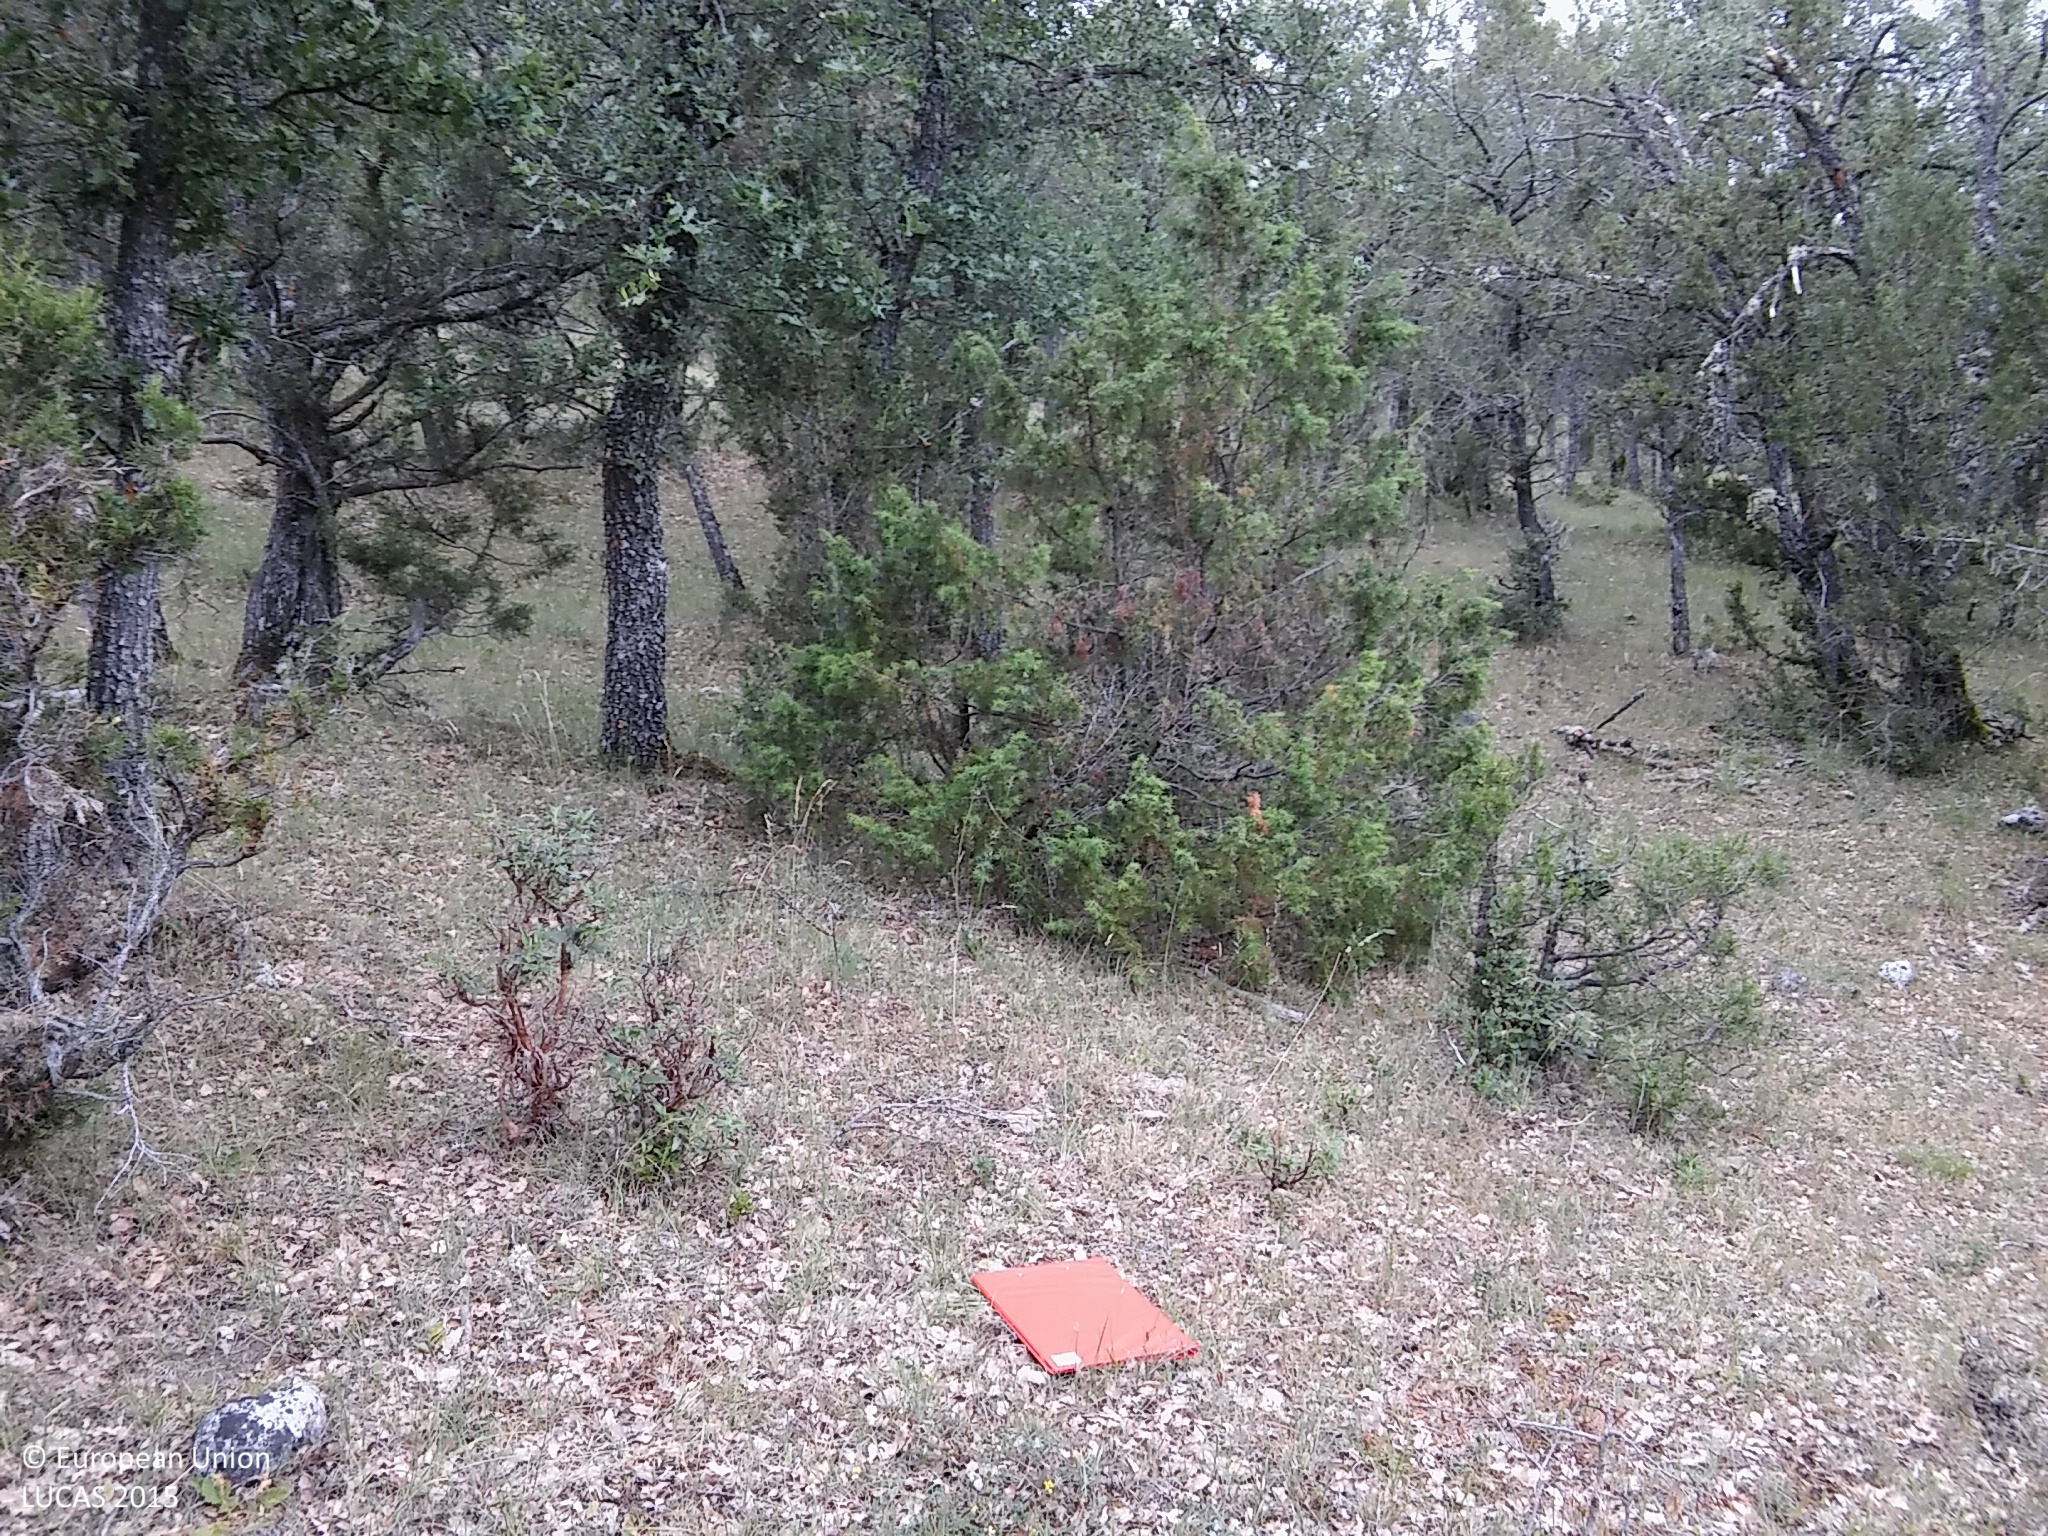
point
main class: Woodland
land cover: Broadleaved woodland
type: acidophilous oak and oak-birch forest
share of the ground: 50 - 75 %
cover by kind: broadleaved forest trees 70 %, herbaceous plants 15 %, unconsolidated bare surface 10 %, shrubs 5 %
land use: Agriculture (excluding fallow land and kitchen gardens)
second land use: Forestry
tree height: > 5 m
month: June
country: ES
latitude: 41.2153
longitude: -3.6318
